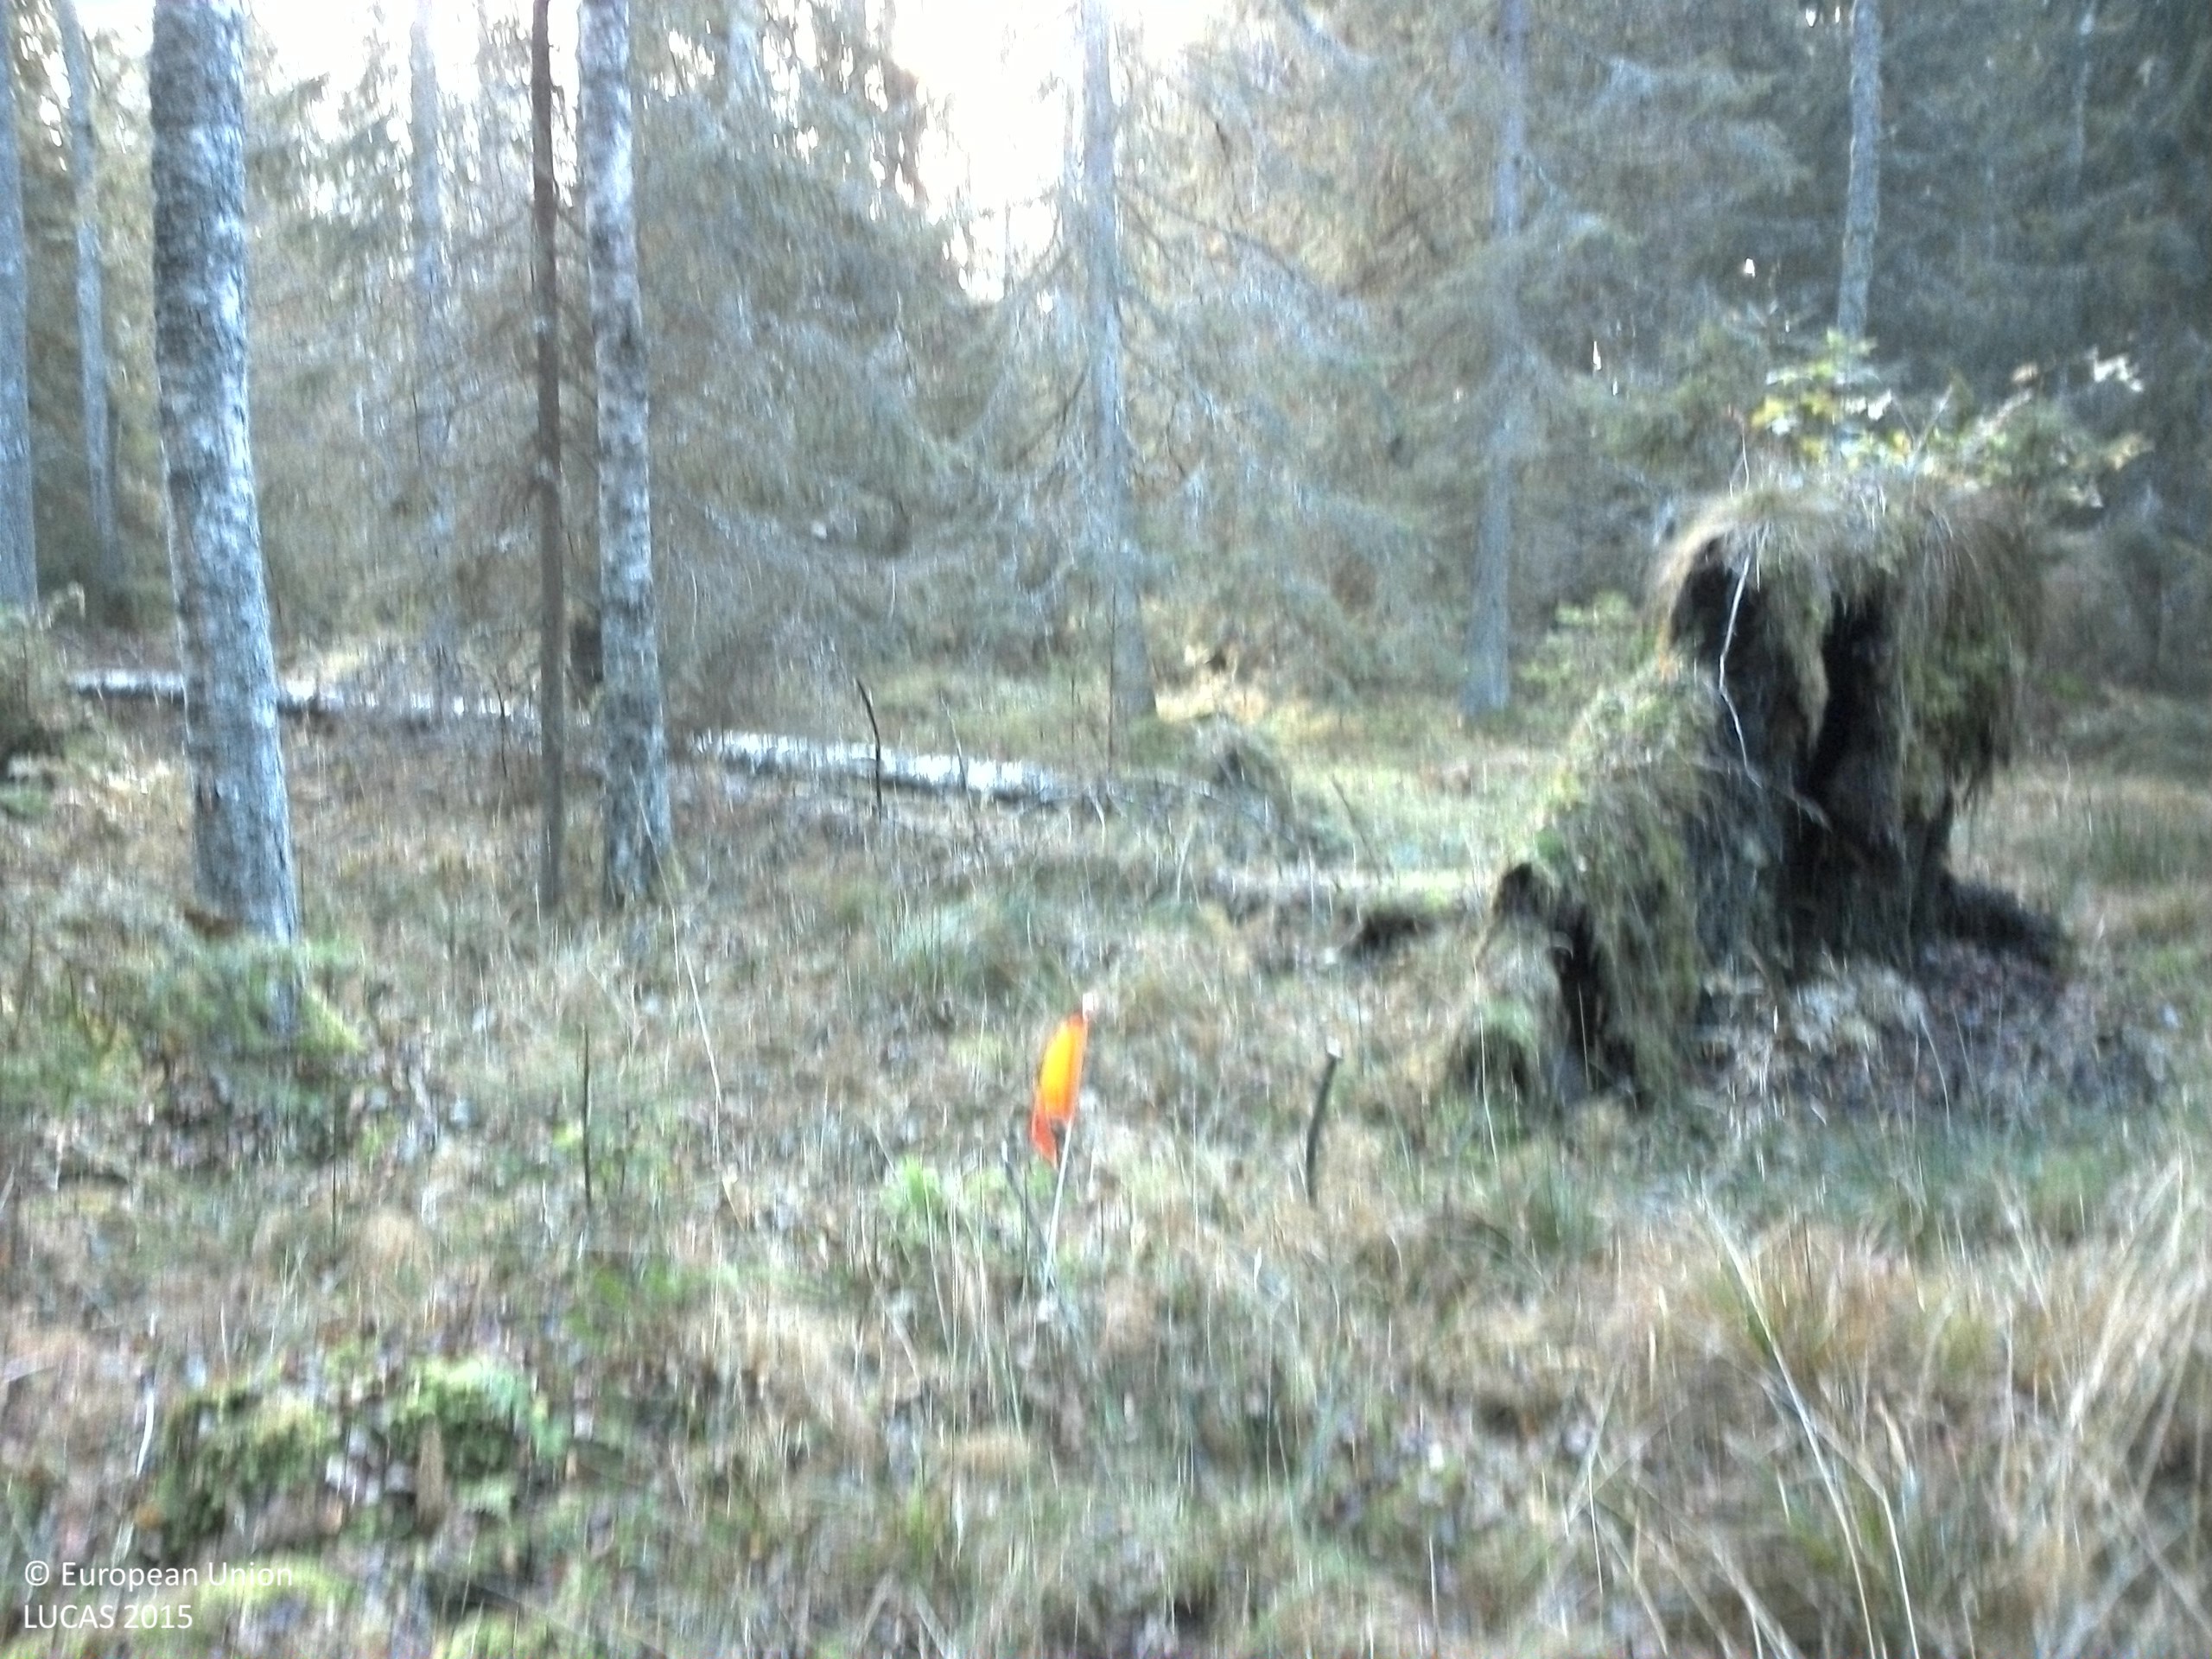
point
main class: Woodland
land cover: Other mixed woodland
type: boreal forest
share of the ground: 50 - 75 %
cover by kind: coniferous forest trees 35 %, broadleaved forest trees 30 %, shrubs 15 %, herbaceous plants 15 %, lichens and mosses 5 %
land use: Forestry
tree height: > 5 m
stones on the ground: < 10 %
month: November
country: SE
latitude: 57.9447
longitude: 14.5390
